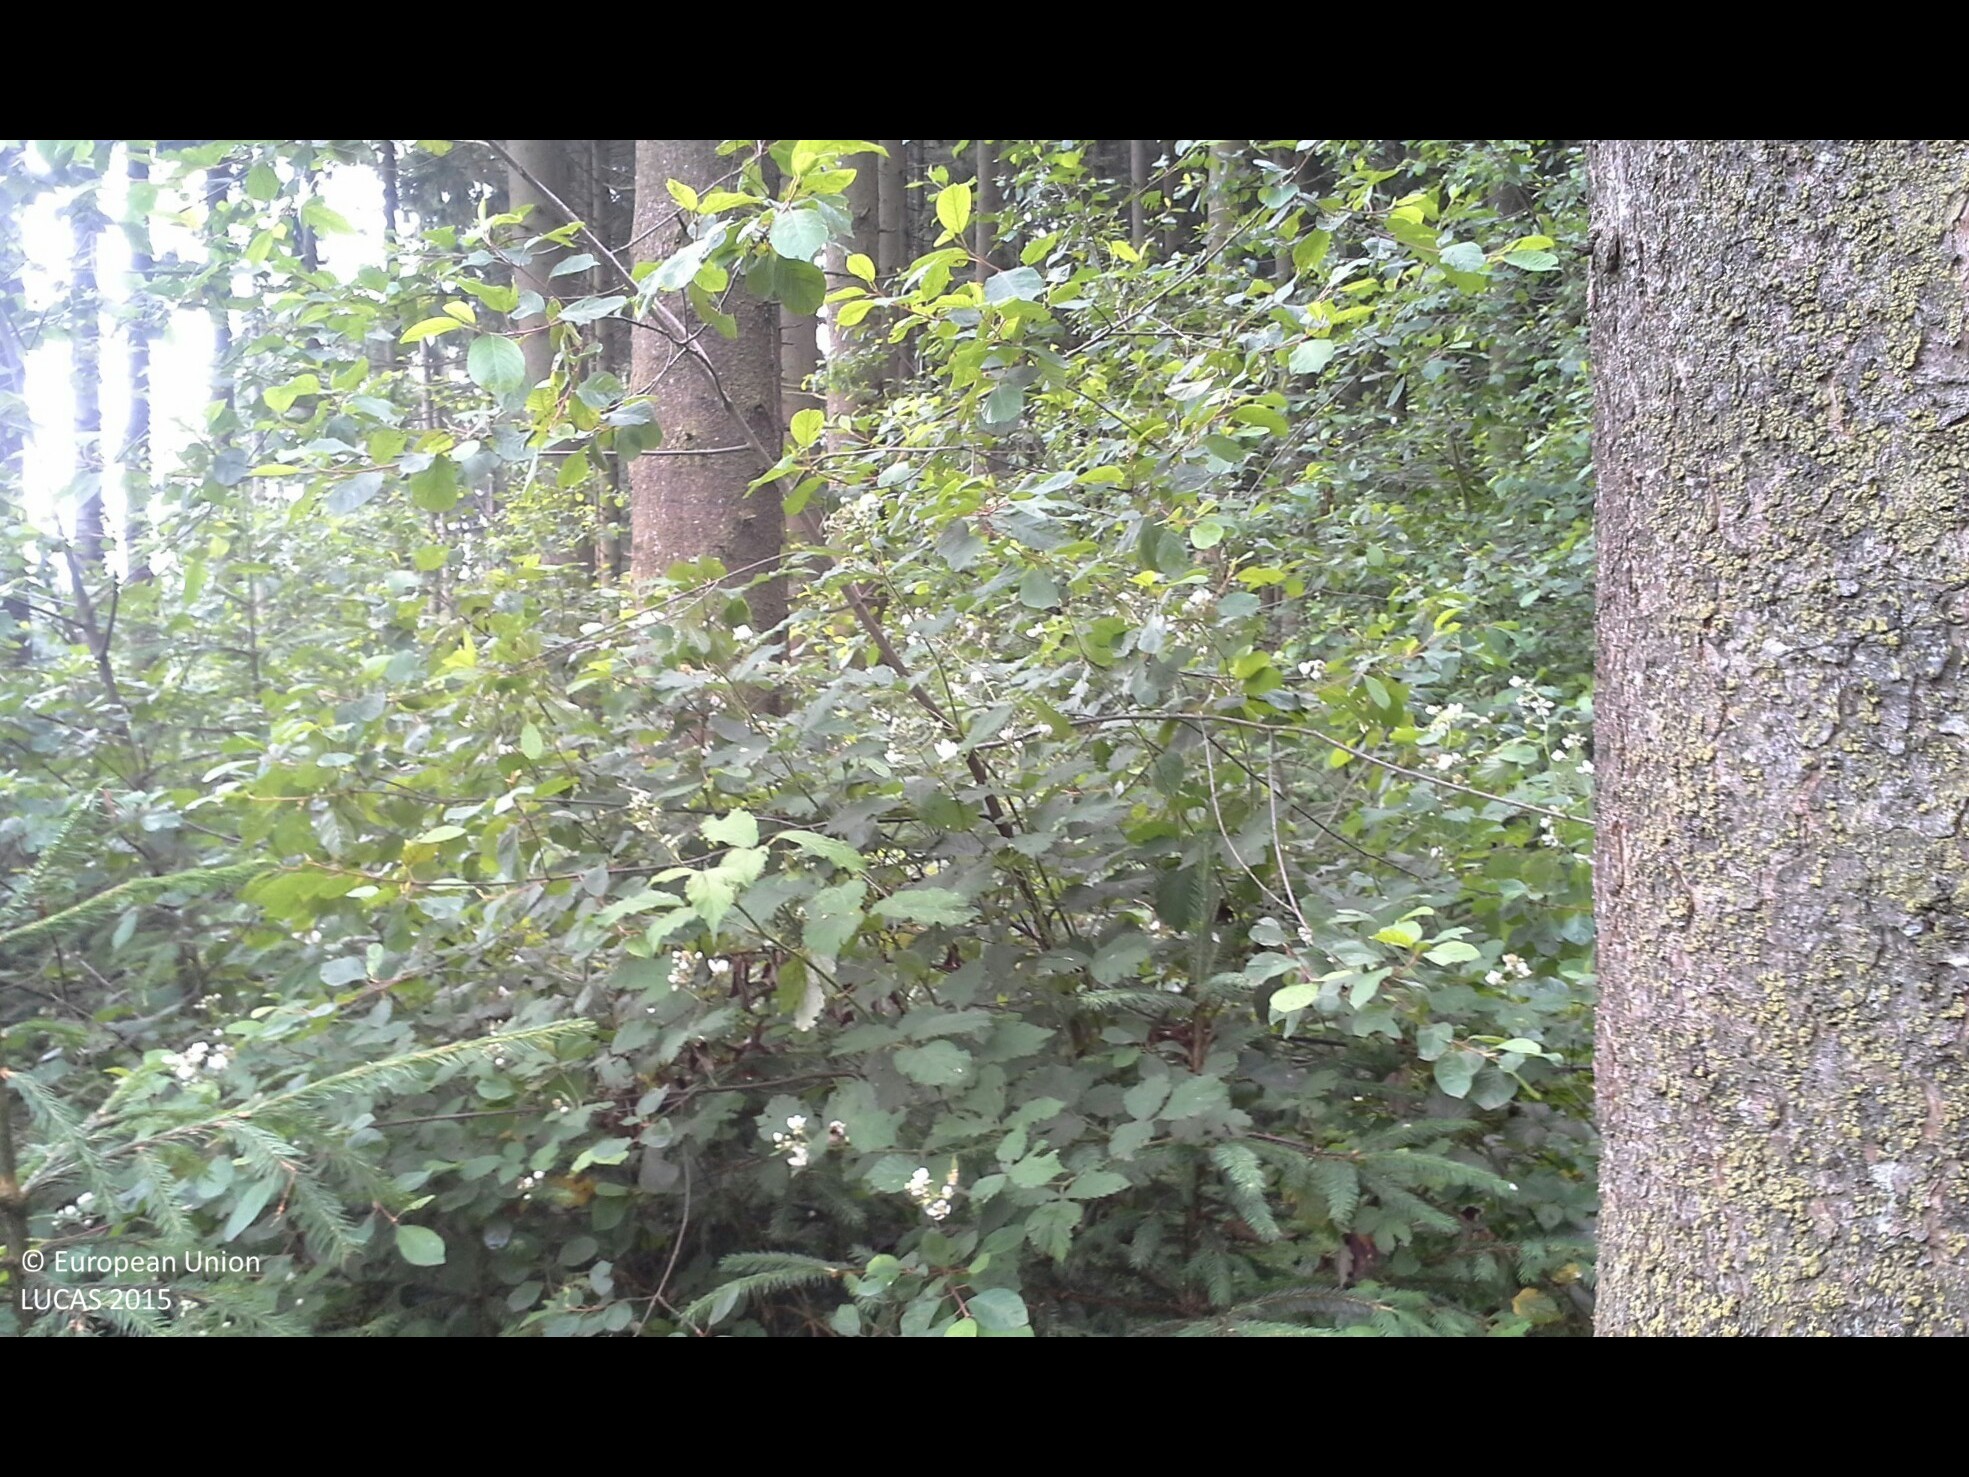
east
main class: Woodland
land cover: Spruce dominated mixed woodland
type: hemiboreal forest and nemoral coniferous forest and mixed broadleaved-coniferous forest
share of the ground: > 75 %
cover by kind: coniferous forest trees 60 %, broadleaved forest trees 25 %, herbaceous plants 10 %, shrubs 5 %
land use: Forestry
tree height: > 5 m
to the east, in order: Spruce dominated mixed woodland; Tracks; Spruce dominated mixed woodland; Tracks; Spruce dominated mixed woodland; Tracks; Spruce dominated mixed woodland; Tracks; Other mixed woodland; Broadleaved woodland; Tracks; Spruce dominated coniferous woodland; Tracks; Spruce dominated coniferous woodland
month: June
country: AT
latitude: 48.0924
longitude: 14.5787
